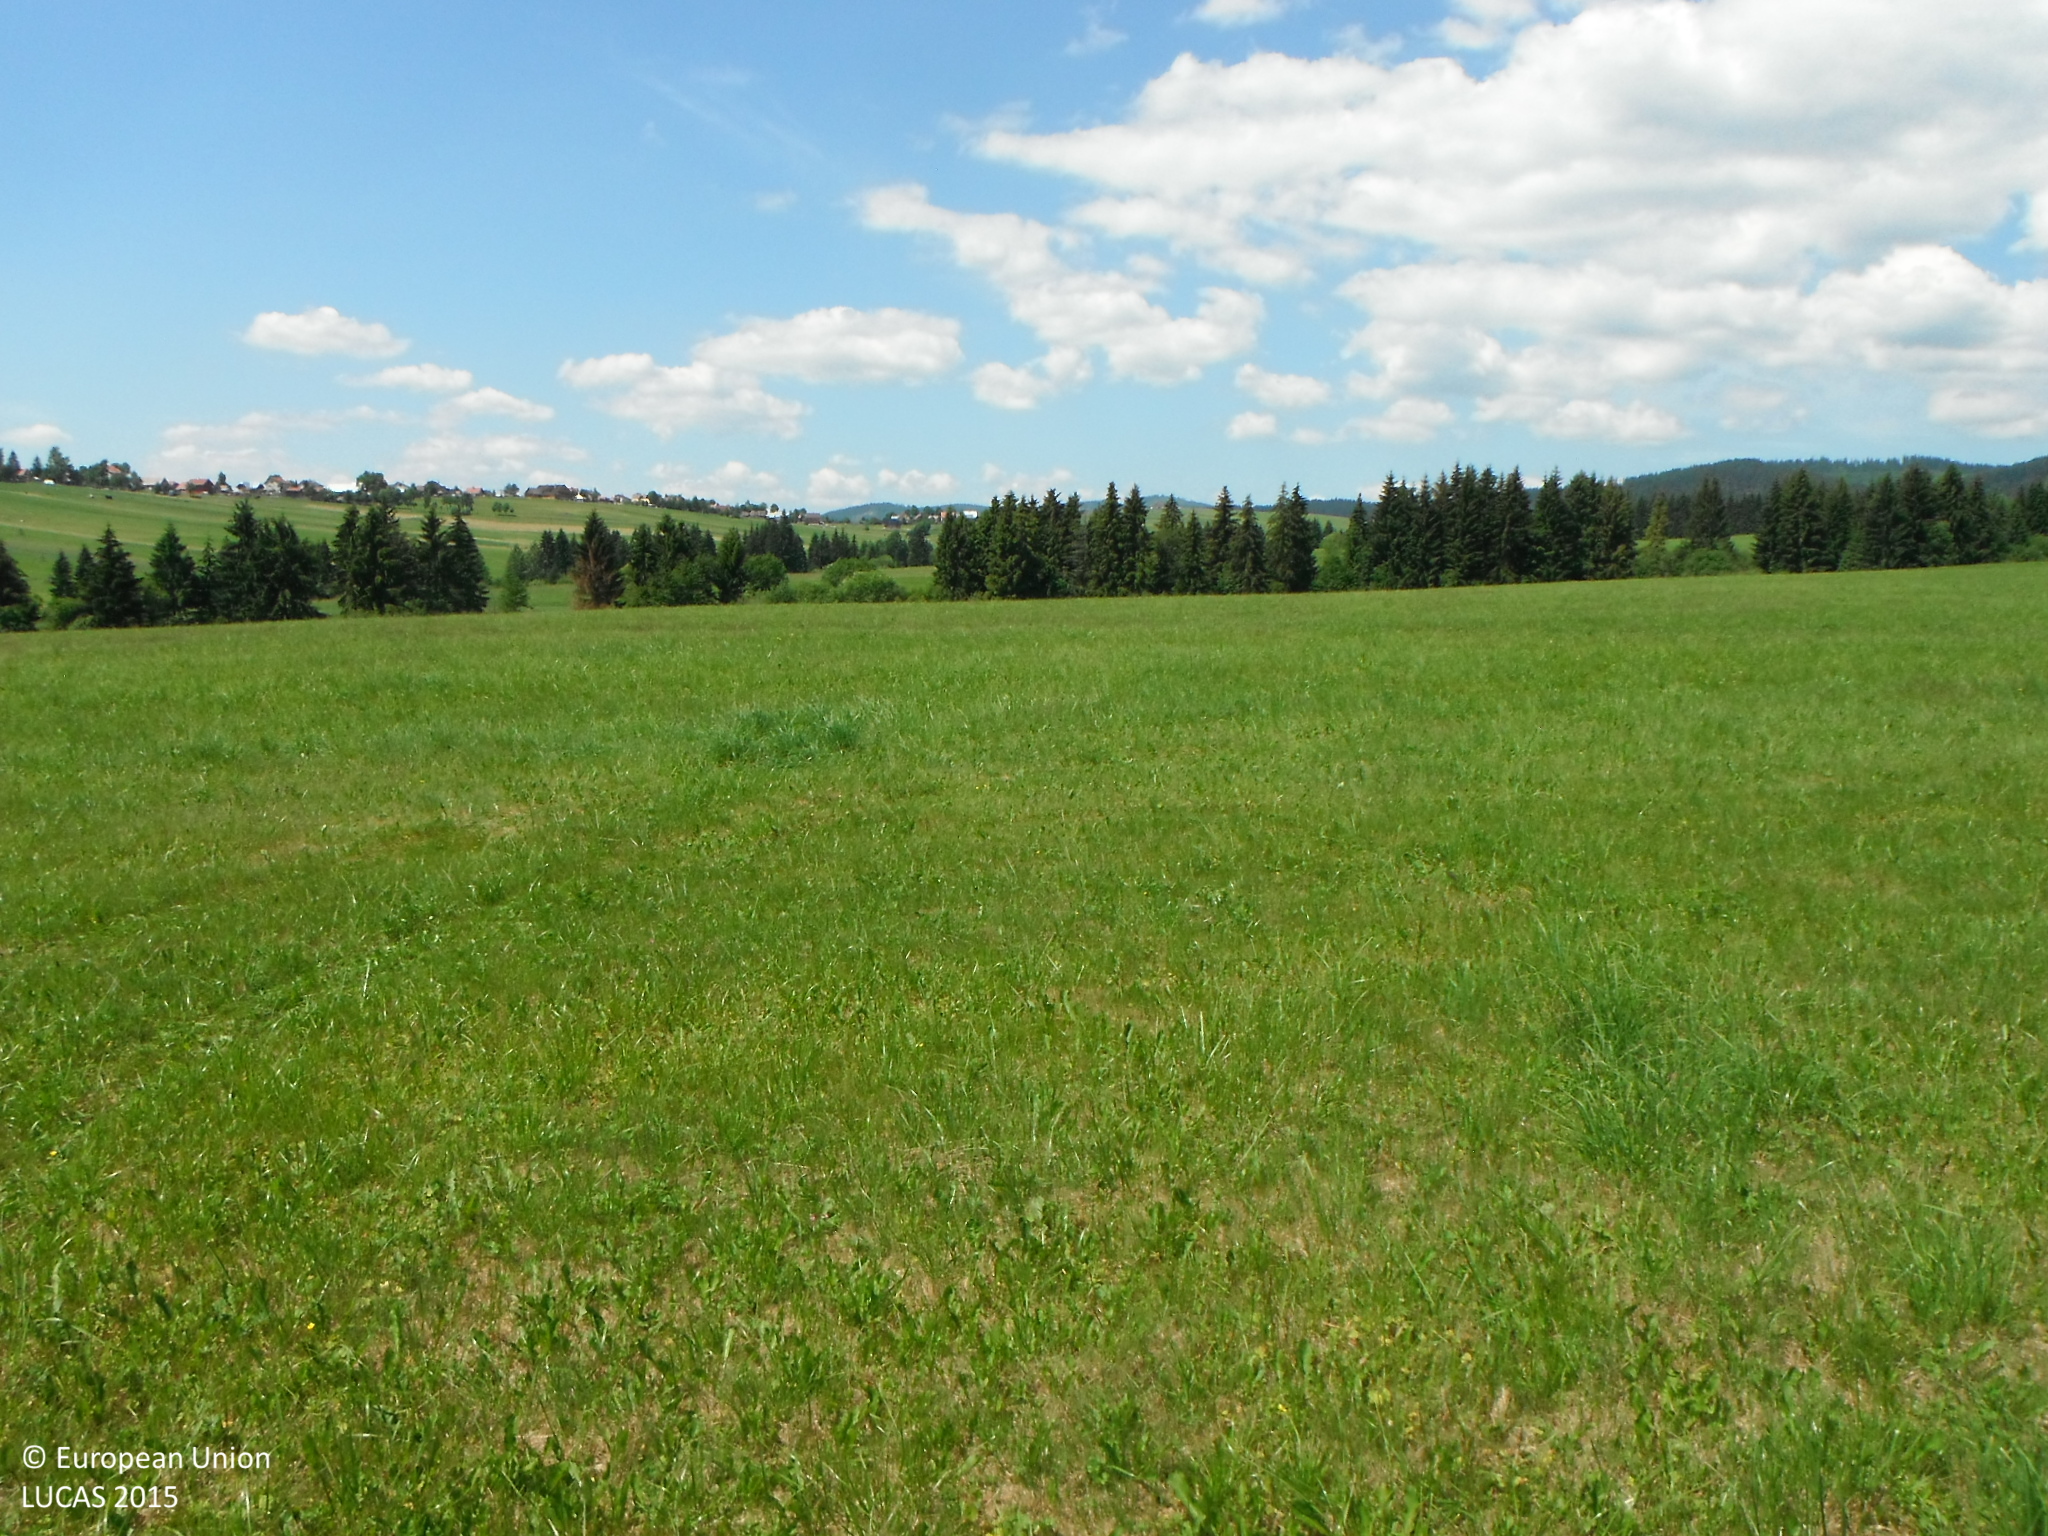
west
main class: Grassland
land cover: Grassland without tree/shrub cover
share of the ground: > 75 %
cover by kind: herbaceous plants 100 %
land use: Agriculture (excluding fallow land and kitchen gardens)
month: July
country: SK
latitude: 49.4742
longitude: 19.3407
